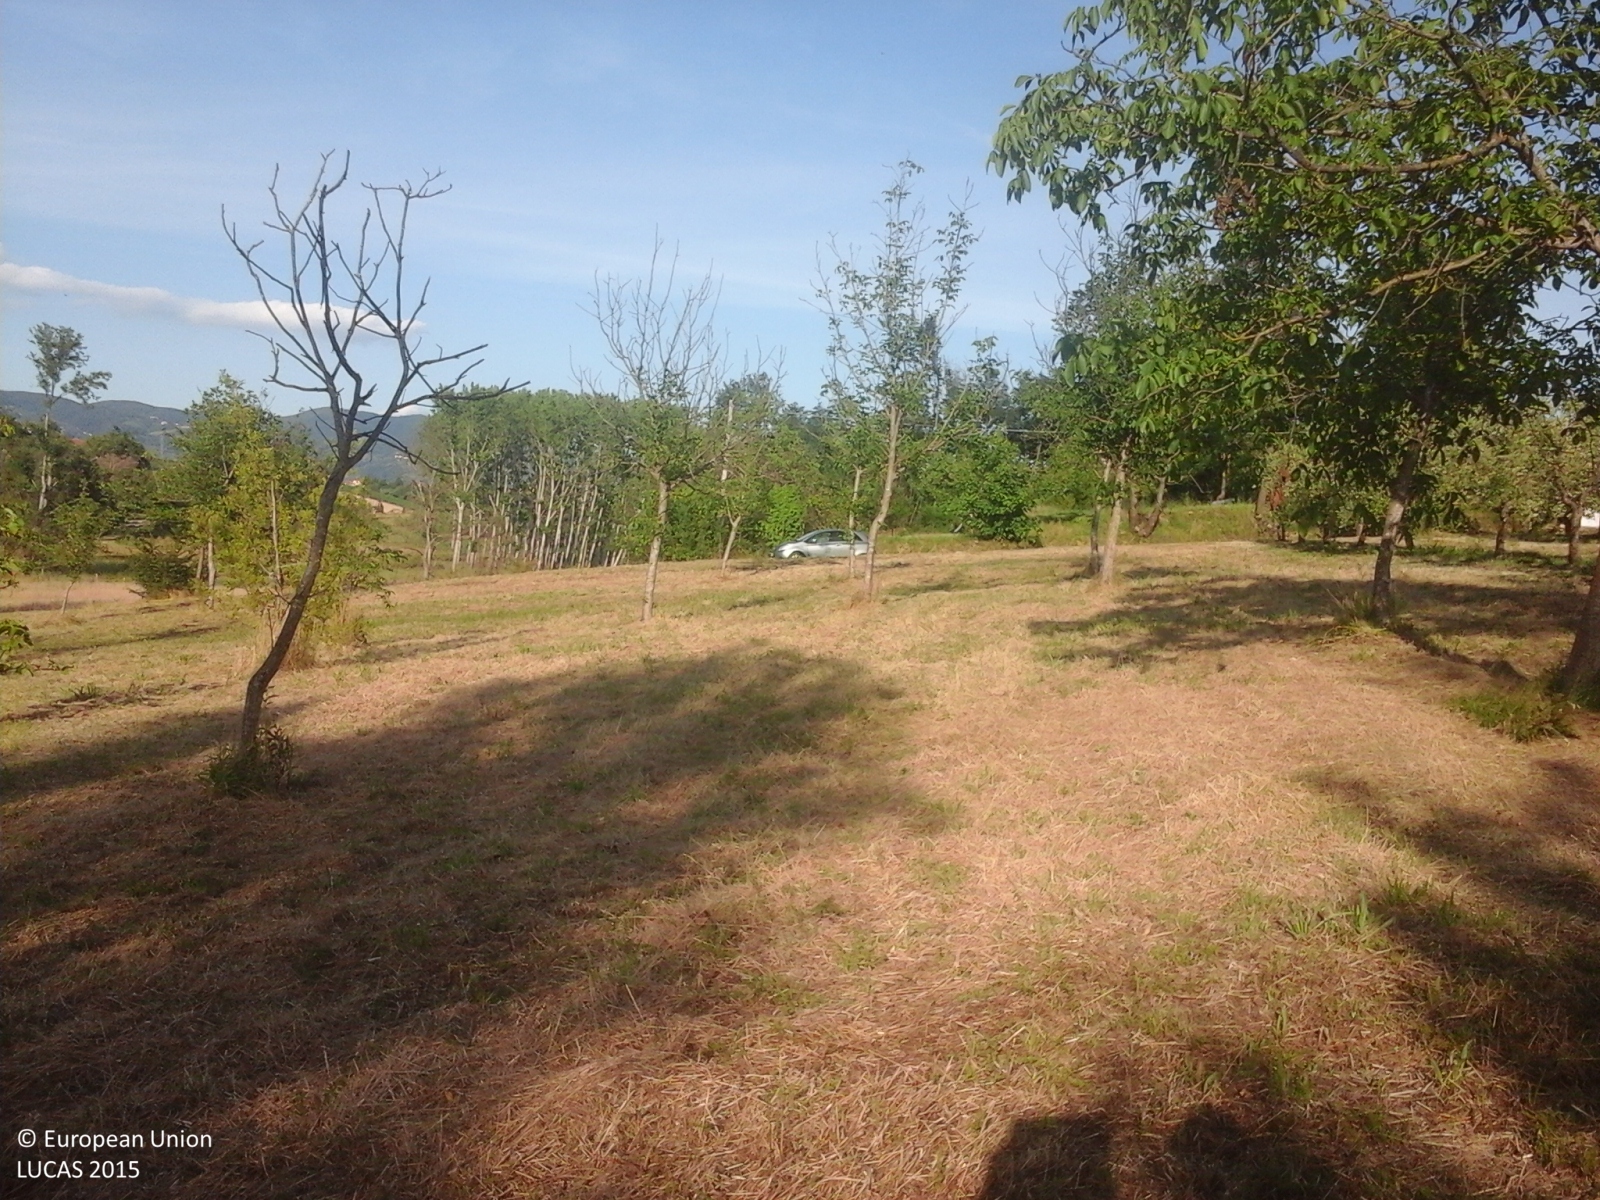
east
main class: Cropland
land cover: Nuts trees
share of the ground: 25 - 50 %
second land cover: Grassland without tree/shrub cover
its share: > 75 %
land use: Agriculture (excluding fallow land and kitchen gardens)
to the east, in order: Nuts trees; Grassland without tree/shrub cover; Single bushes/trees; Grassland without tree/shrub cover; Fences; Tracks; Electric lines; Broadleaved woodland; Fences; Nuts trees
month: June
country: IT
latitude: 43.7878
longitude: 10.8552
